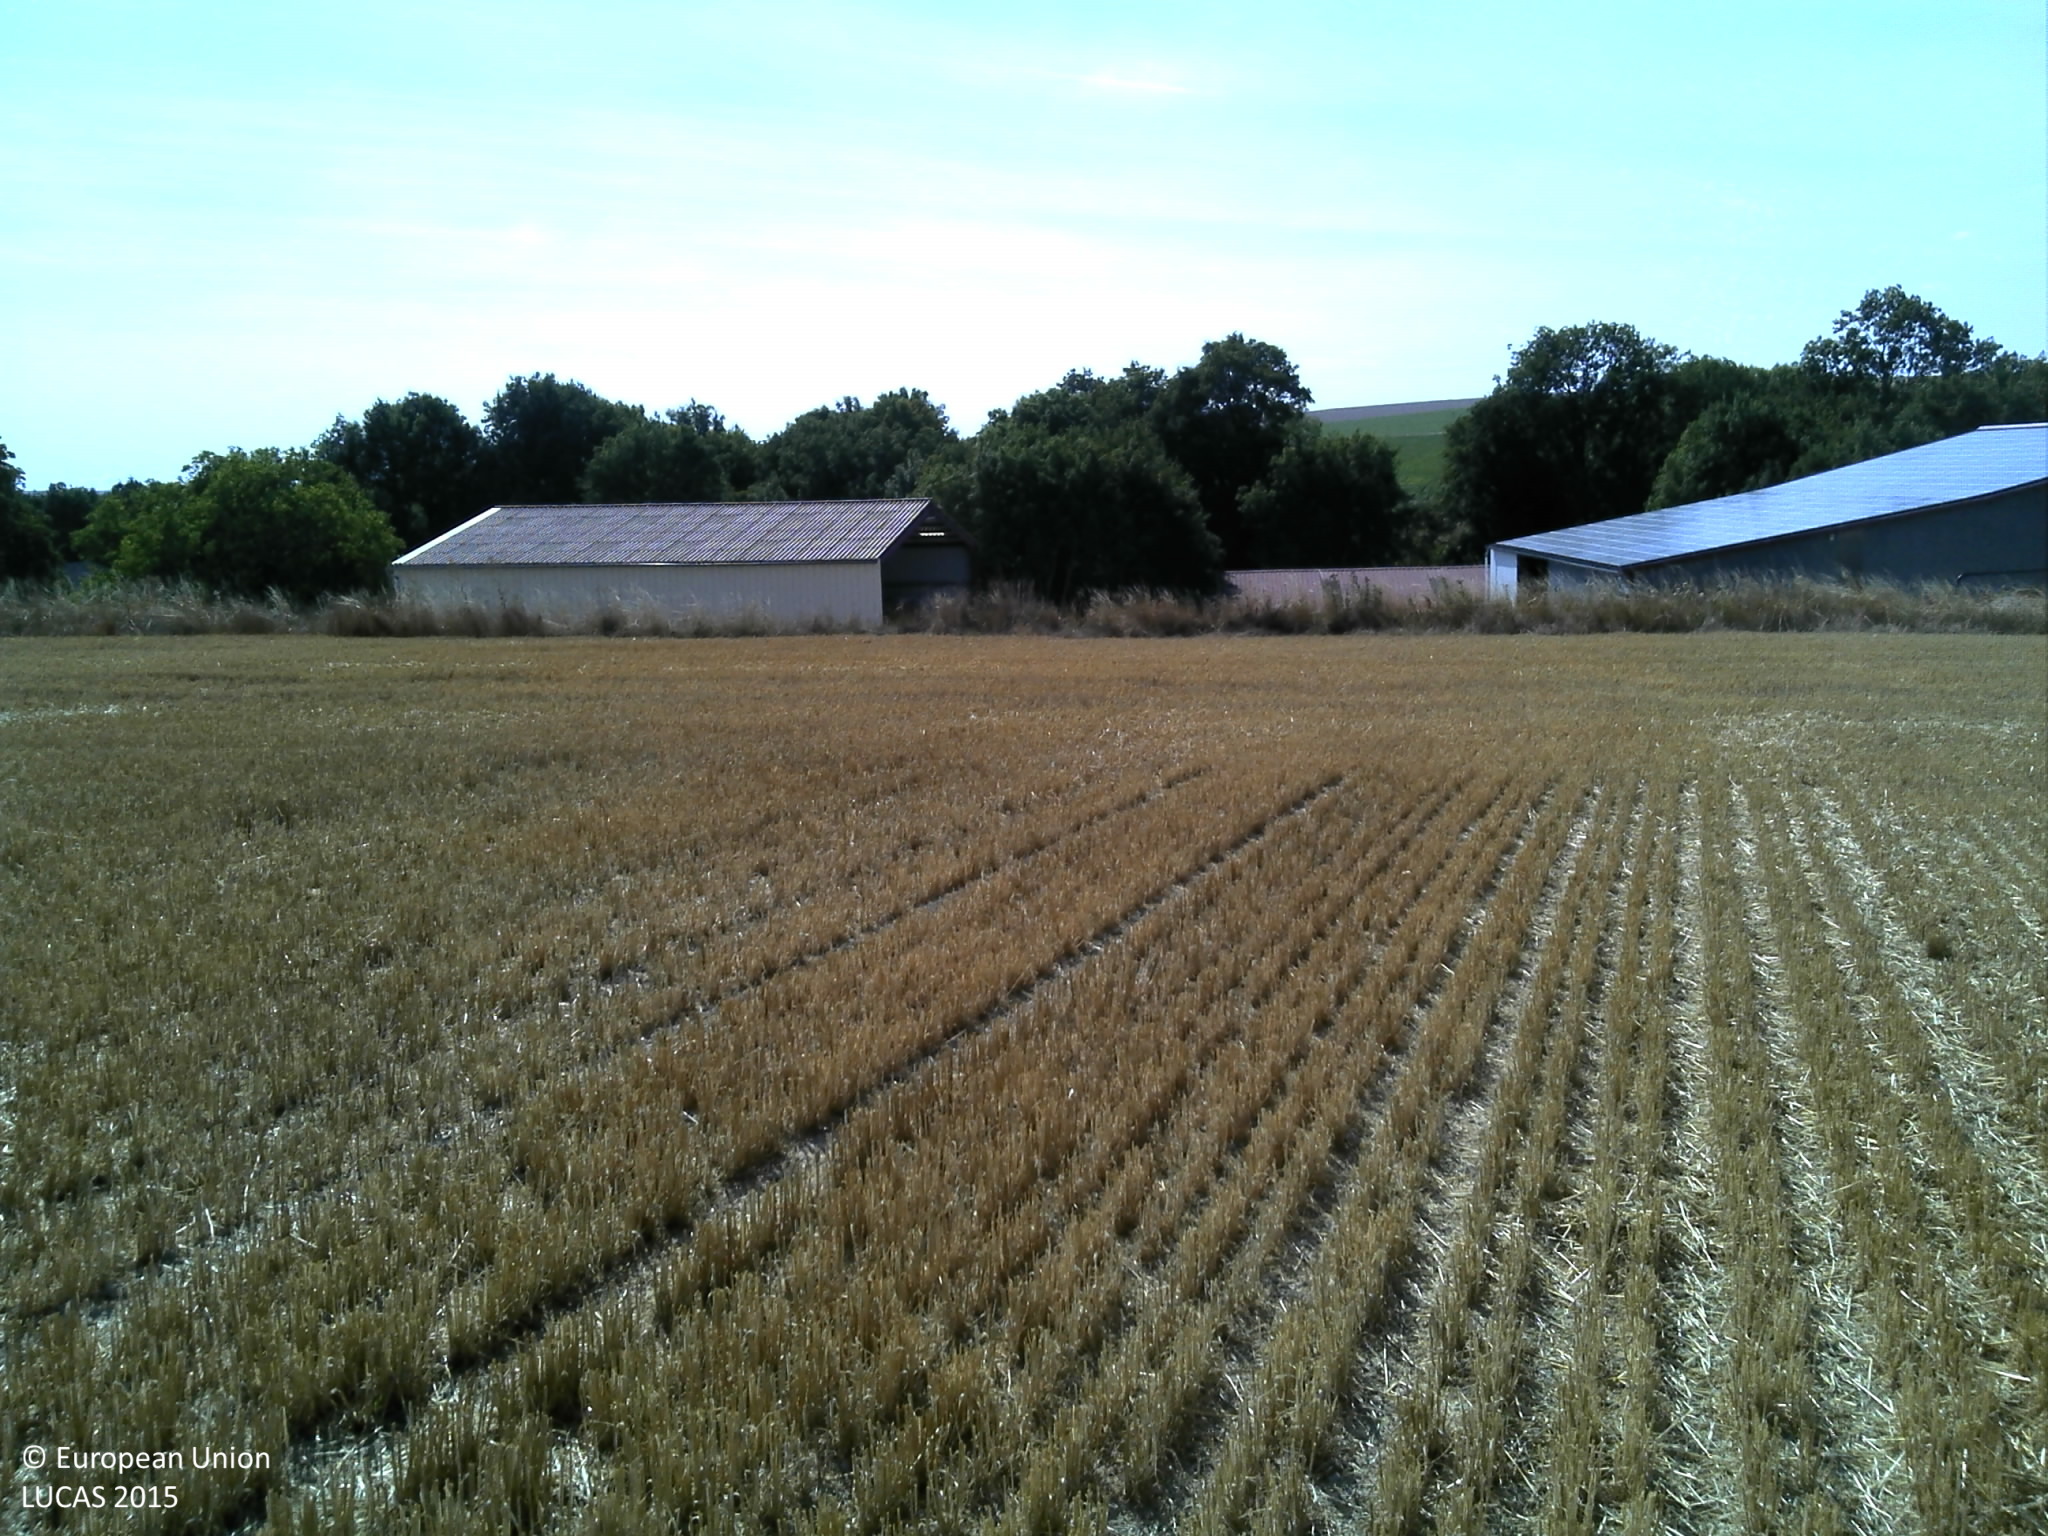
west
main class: Cropland
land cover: Barley
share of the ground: > 75 %
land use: Agriculture (excluding fallow land and kitchen gardens)
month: August
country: FR
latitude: 48.9236
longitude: 4.6608
